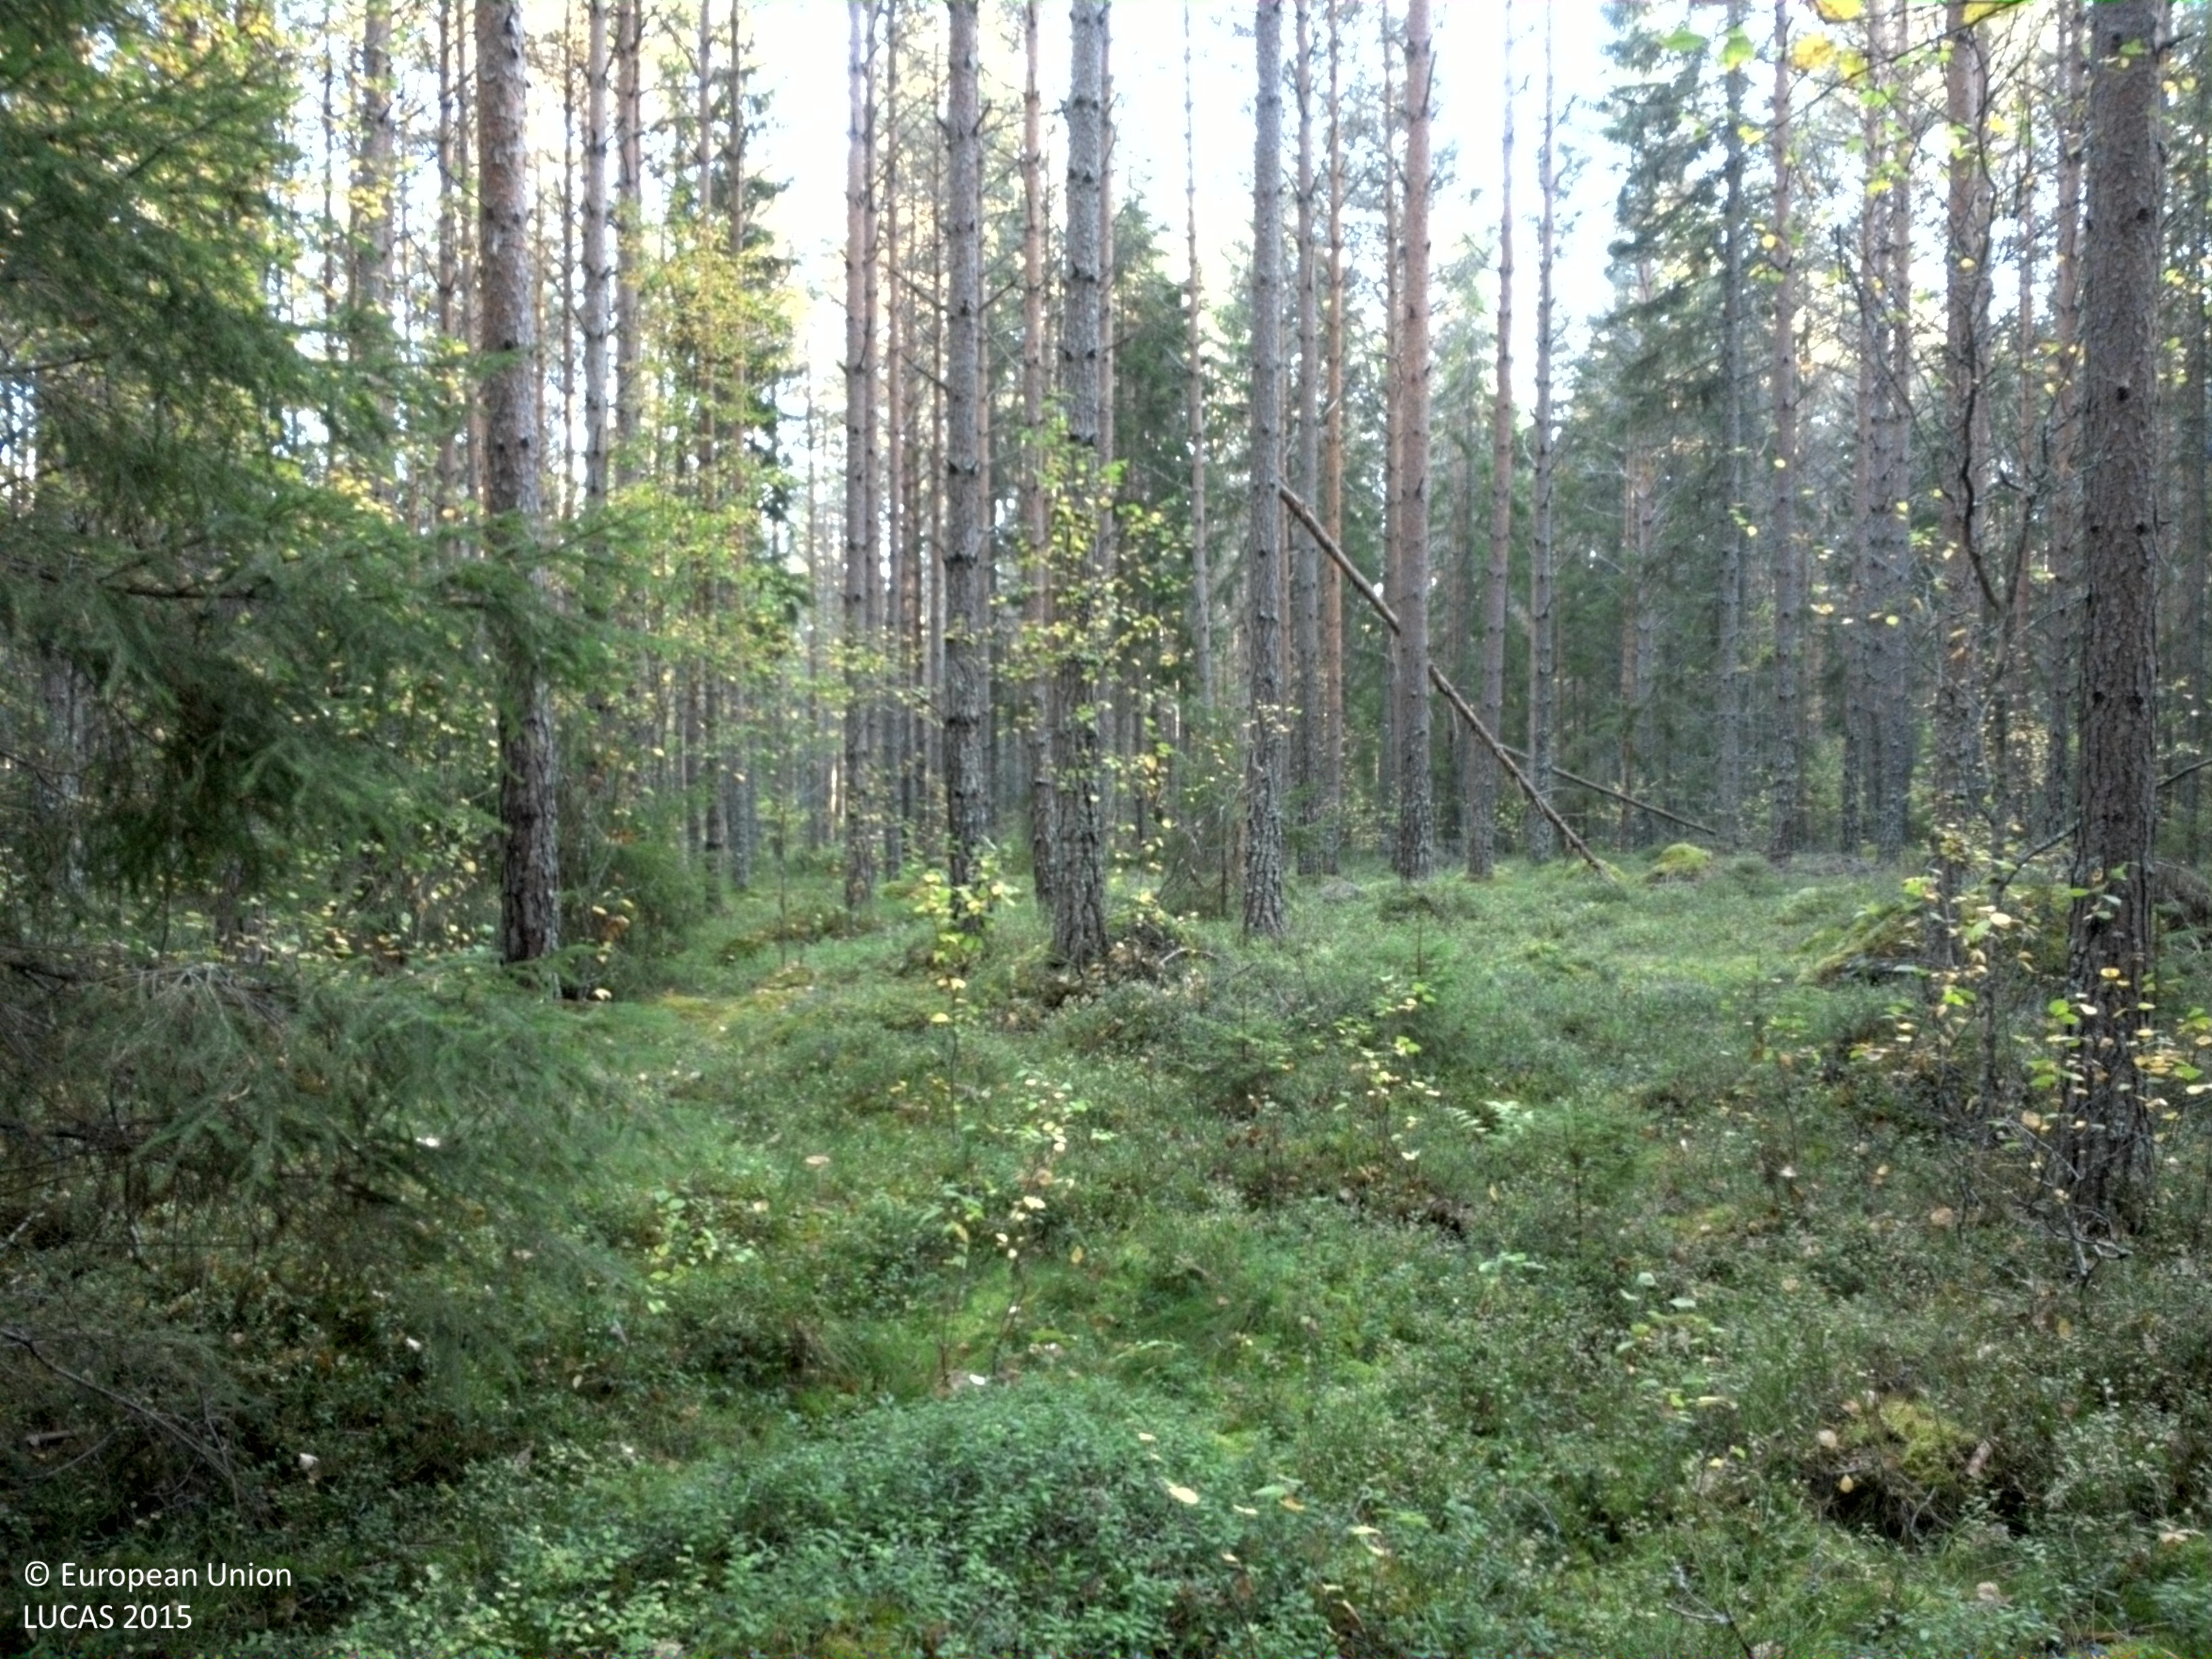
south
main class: Woodland
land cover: Pine dominated coniferous woodland
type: boreal forest
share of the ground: > 75 %
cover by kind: coniferous forest trees 70 %, broadleaved forest trees 15 %, lichens and mosses 15 %
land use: Forestry
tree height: > 5 m
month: September
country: SE
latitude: 59.9931
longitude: 16.5338
